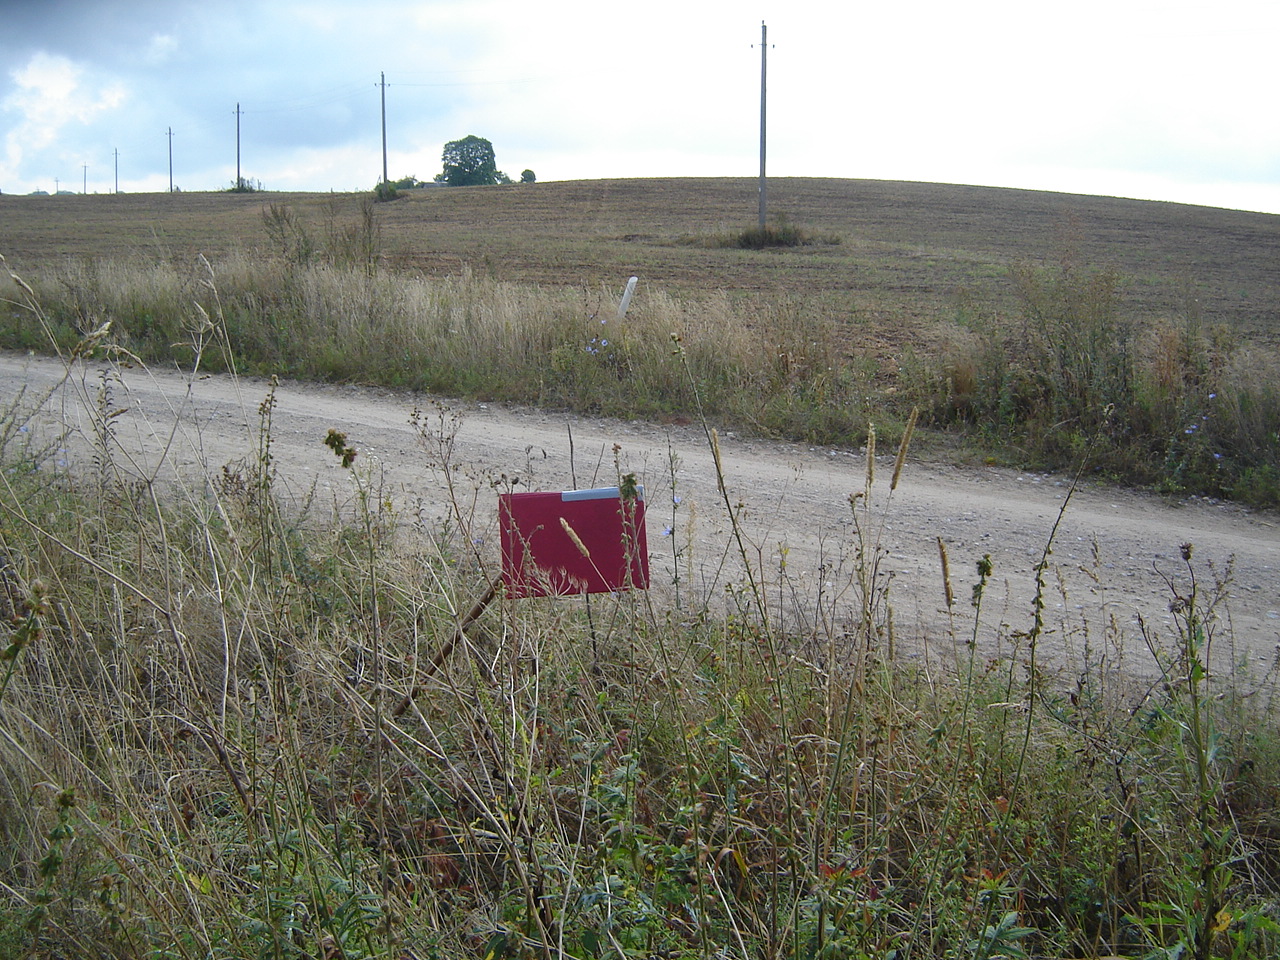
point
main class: Grassland
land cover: Grassland with sparse tree/shrub cover
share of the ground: > 75 %
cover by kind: herbaceous plants 90 %, coniferous forest trees 5 %, shrubs 5 %
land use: Fallow land
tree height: > 5 m
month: August
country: LT
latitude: 54.7280
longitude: 24.7194
